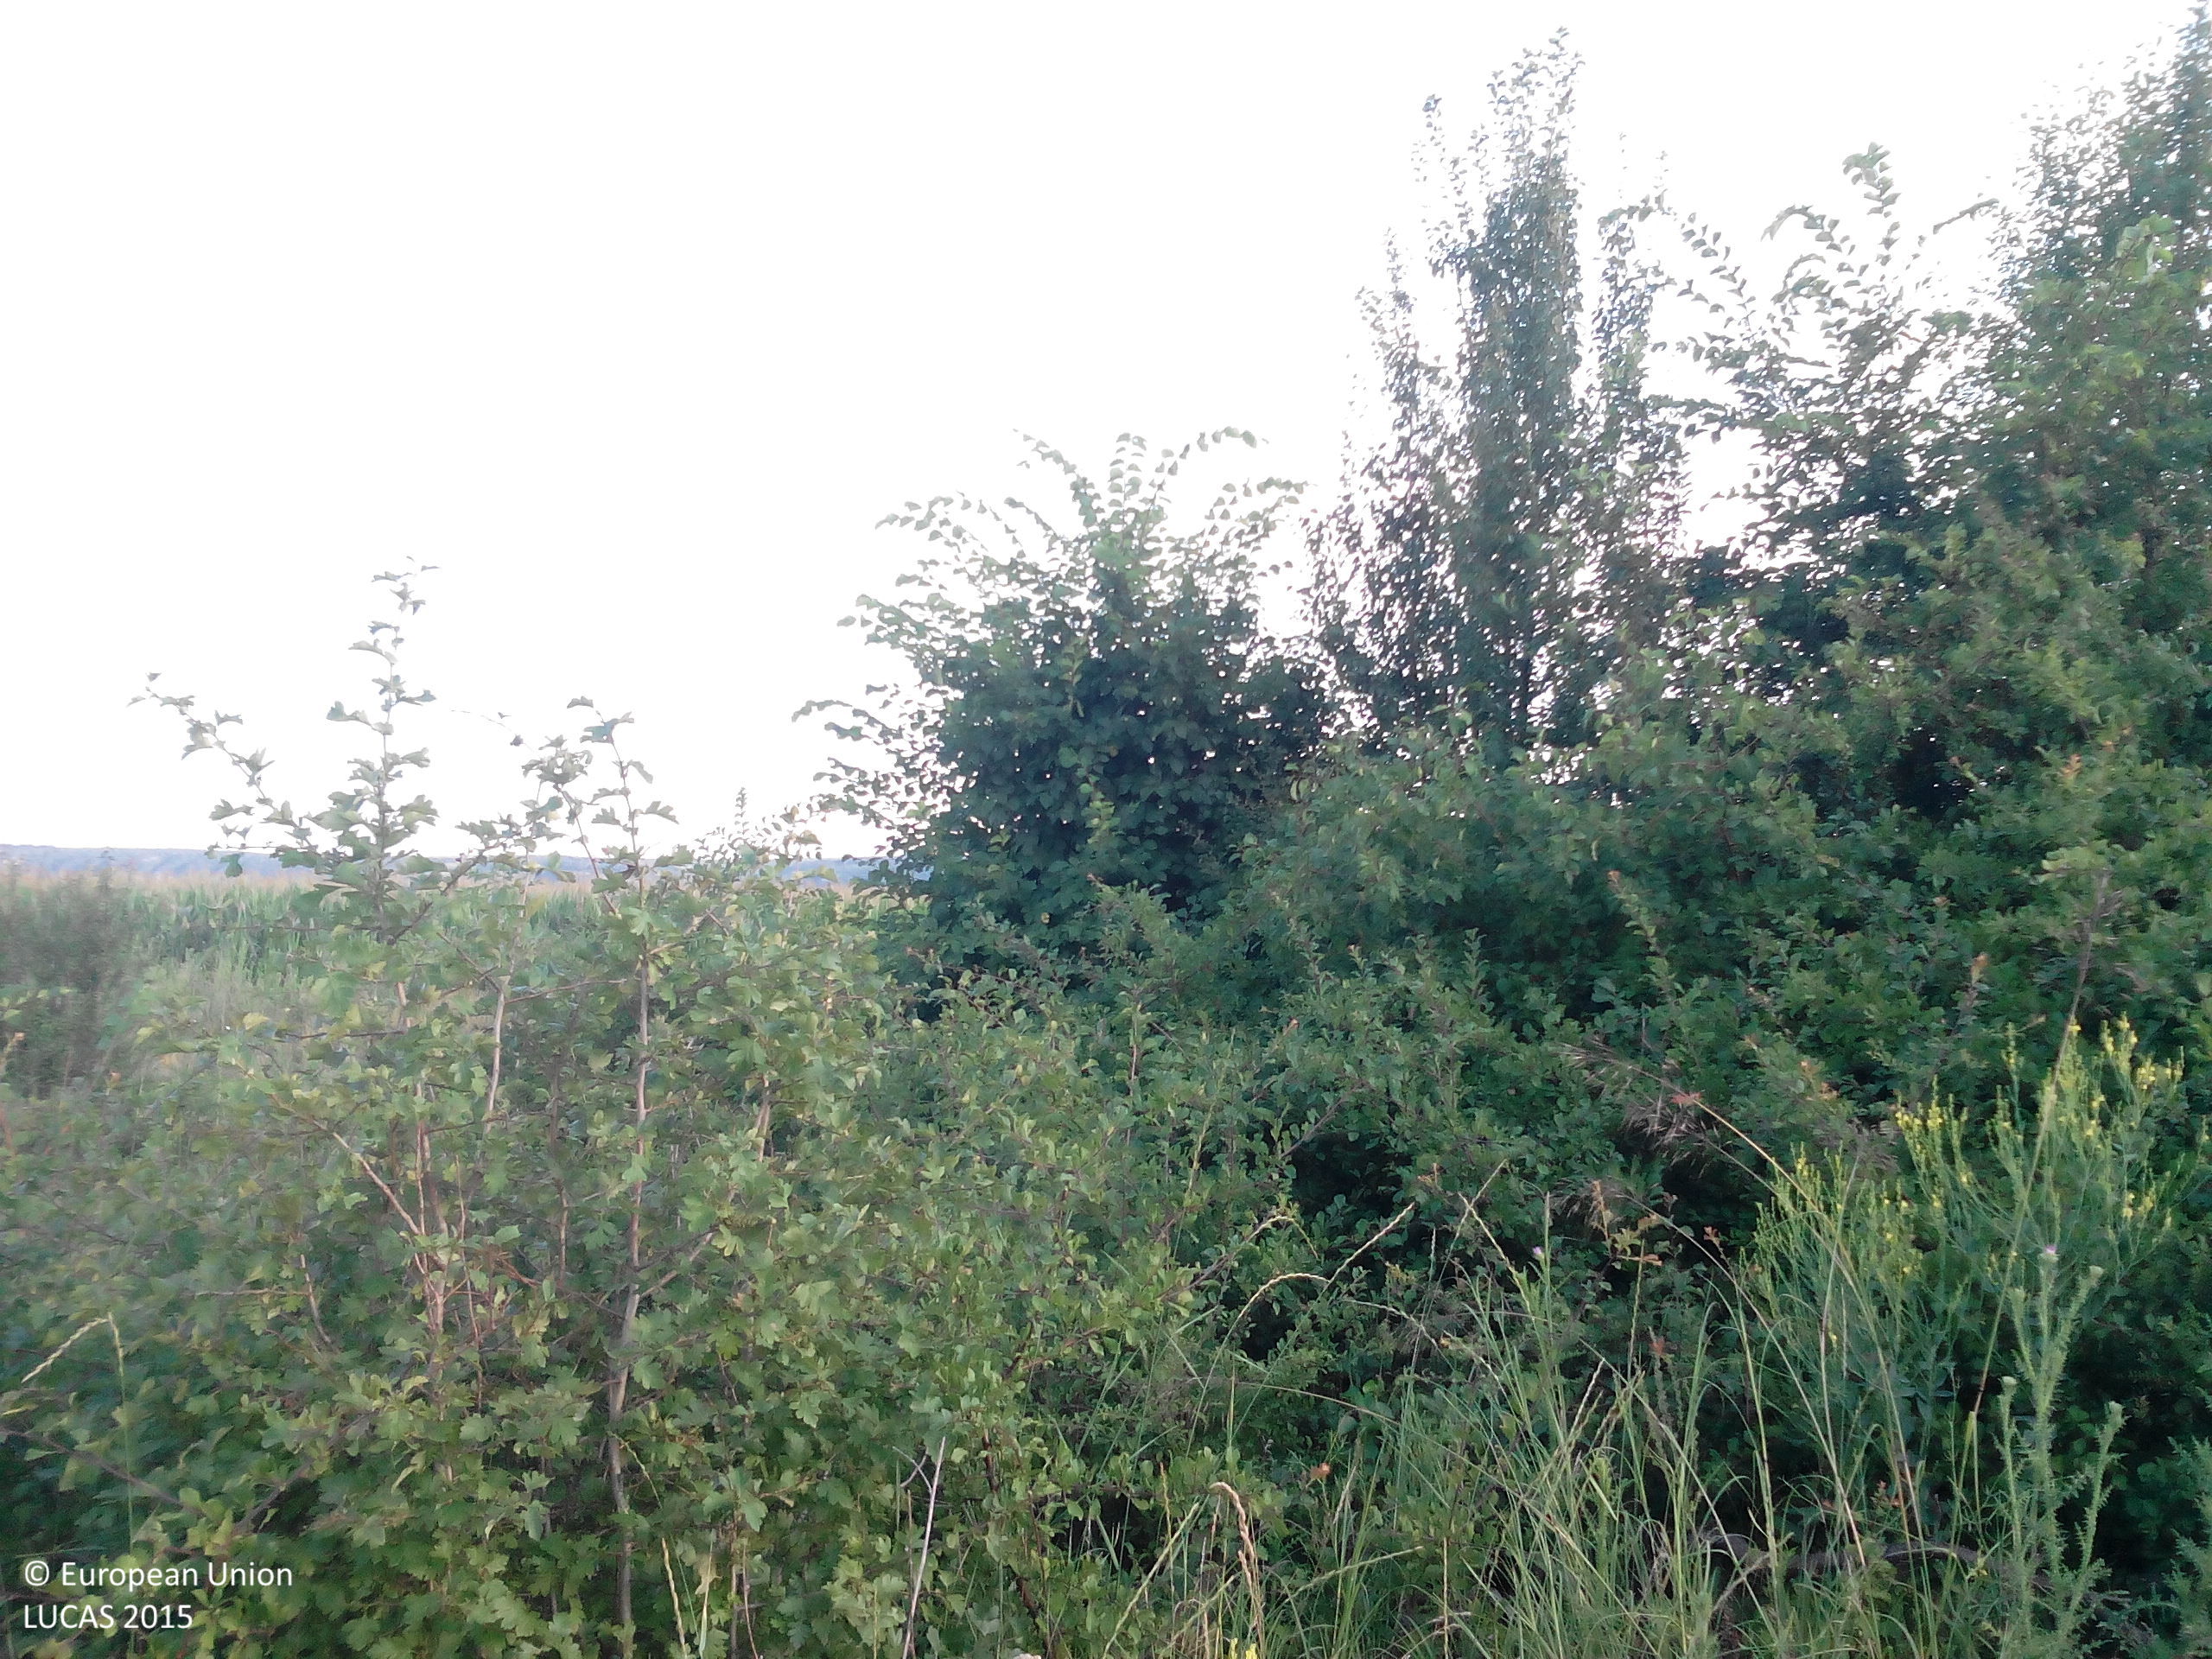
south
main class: Shrubland
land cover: Shrubland with sparse tree cover
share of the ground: > 75 %
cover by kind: shrubs 90 %, broadleaved forest trees 5 %, herbaceous plants 5 %
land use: Abandoned areas
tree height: < 5 m
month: July
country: BG
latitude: 43.3451
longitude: 24.1037
